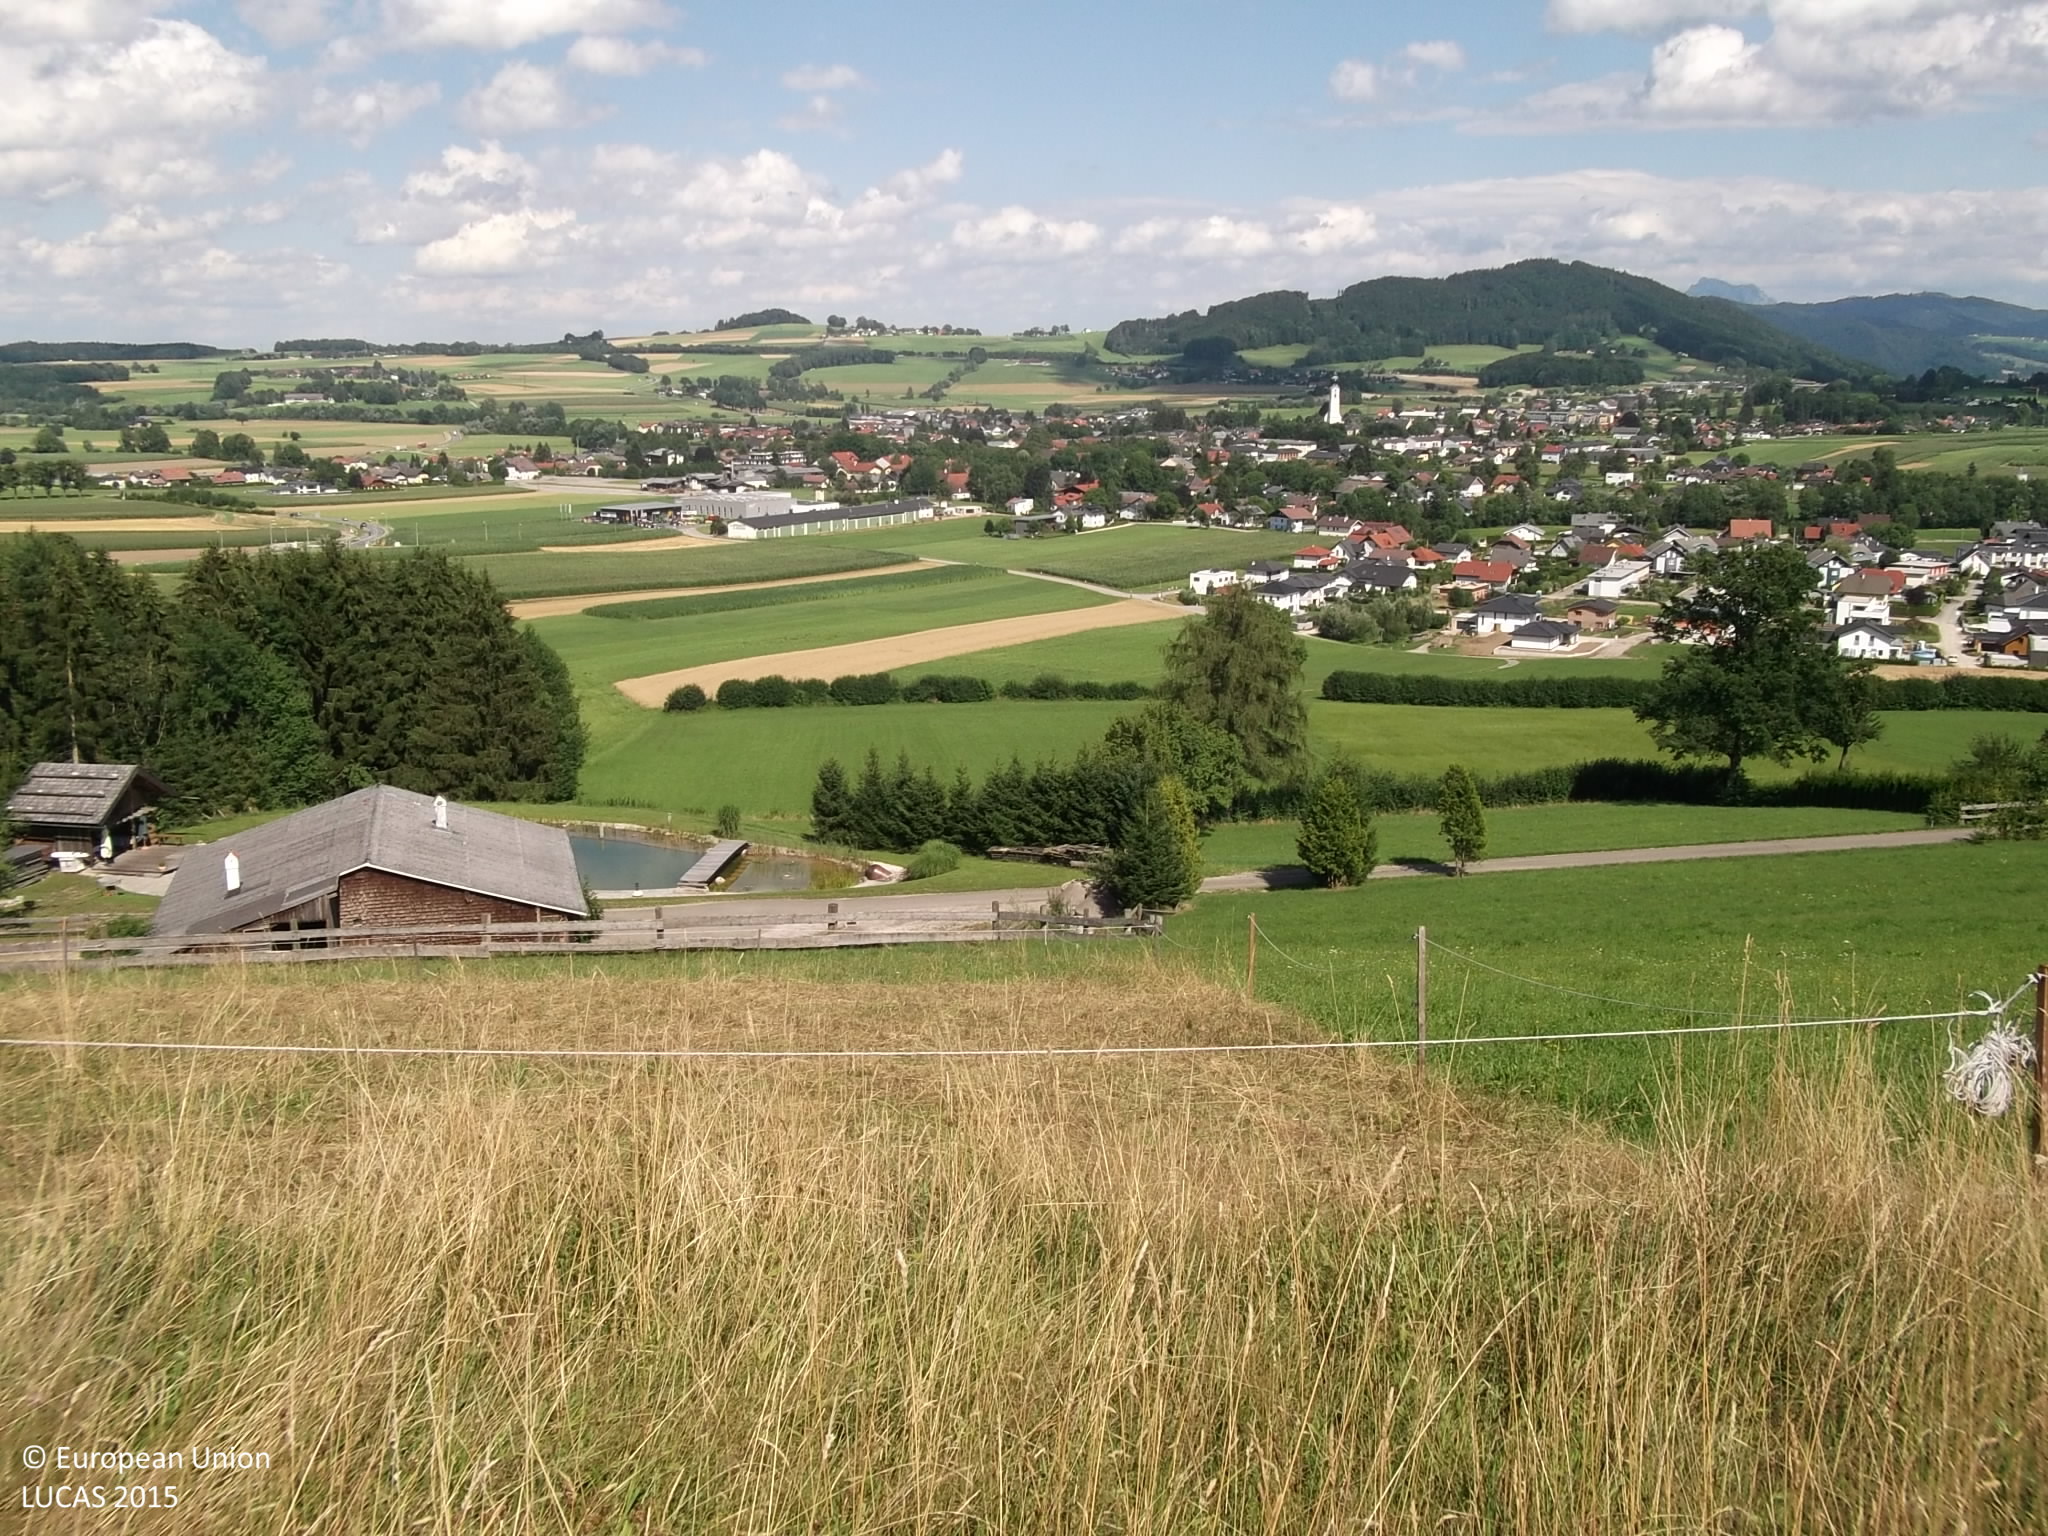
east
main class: Grassland
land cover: Grassland without tree/shrub cover
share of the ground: > 75 %
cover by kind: herbaceous plants 100 %
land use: Agriculture (excluding fallow land and kitchen gardens)
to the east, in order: Grassland without tree/shrub cover; Fences; Grassland without tree/shrub cover; Fences; Grassland without tree/shrub cover; Paved roads, cycling and walking lanes; Grassland without tree/shrub cover; Single bushes/trees; Tracks; Broadleaved woodland; Grassland without tree/shrub cover
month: July
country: AT
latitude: 47.9349
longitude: 13.4659
